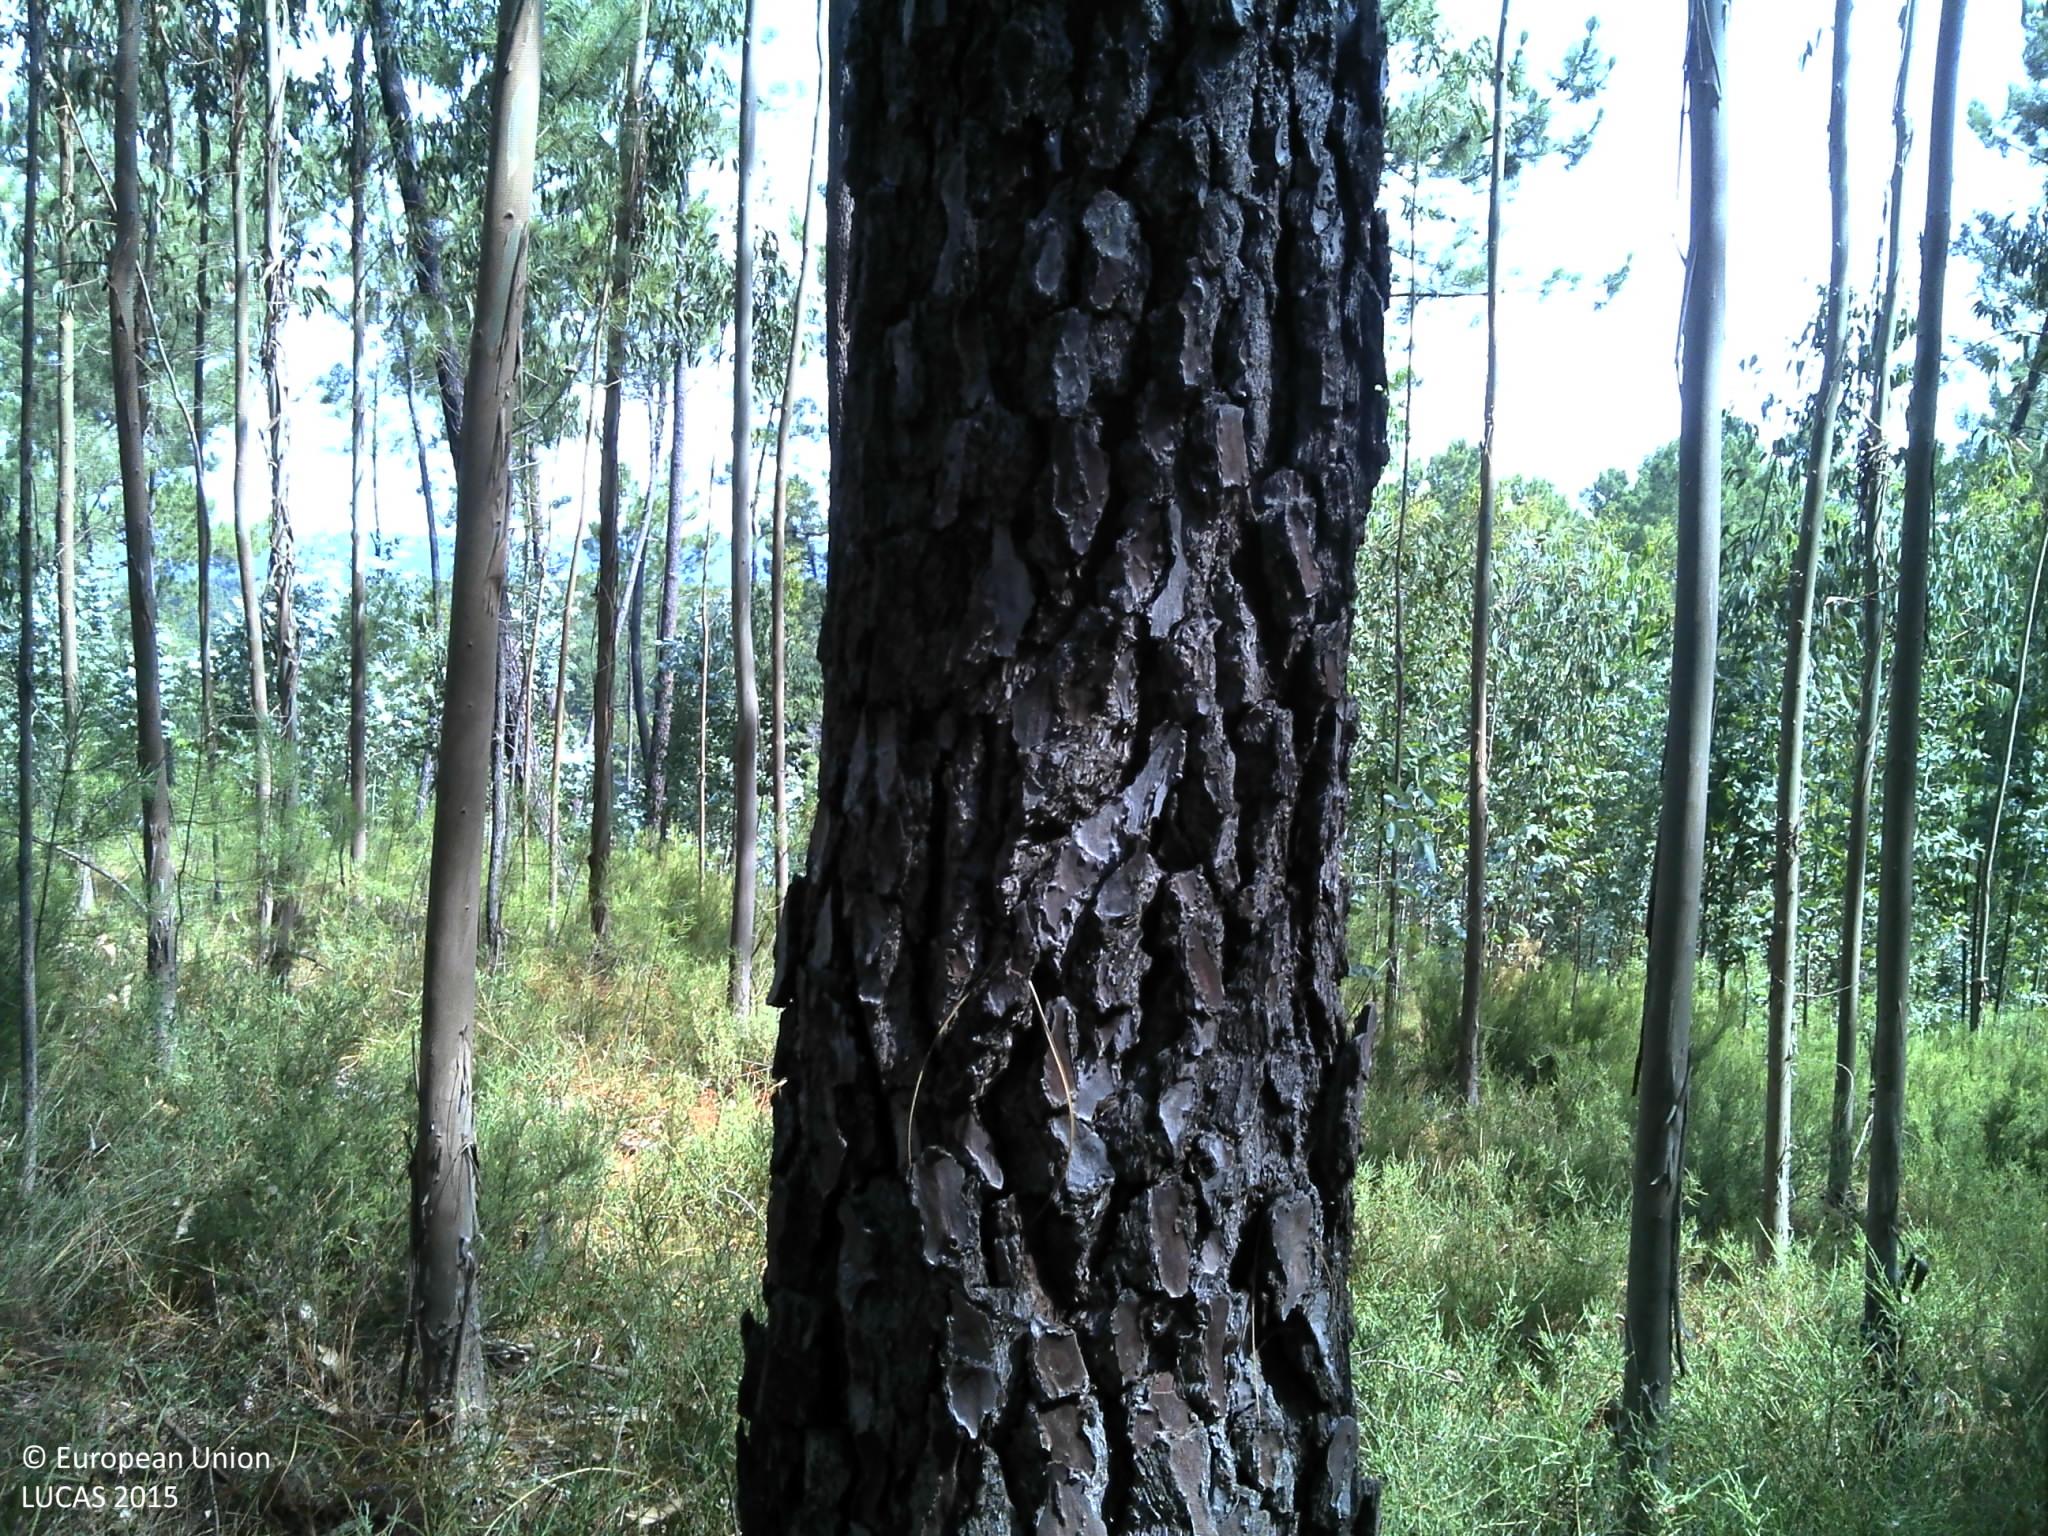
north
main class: Woodland
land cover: Pine dominated mixed woodland
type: coniferous forest of the mediterranean region
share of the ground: 25 - 50 %
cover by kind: shrubs 40 %, coniferous forest trees 15 %, broadleaved forest trees 10 %, consolidated bare surface 10 %, unconsolidated bare surface 10 %
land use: Forestry
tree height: > 5 m
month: July
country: PT
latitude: 39.8959
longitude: -8.1156
